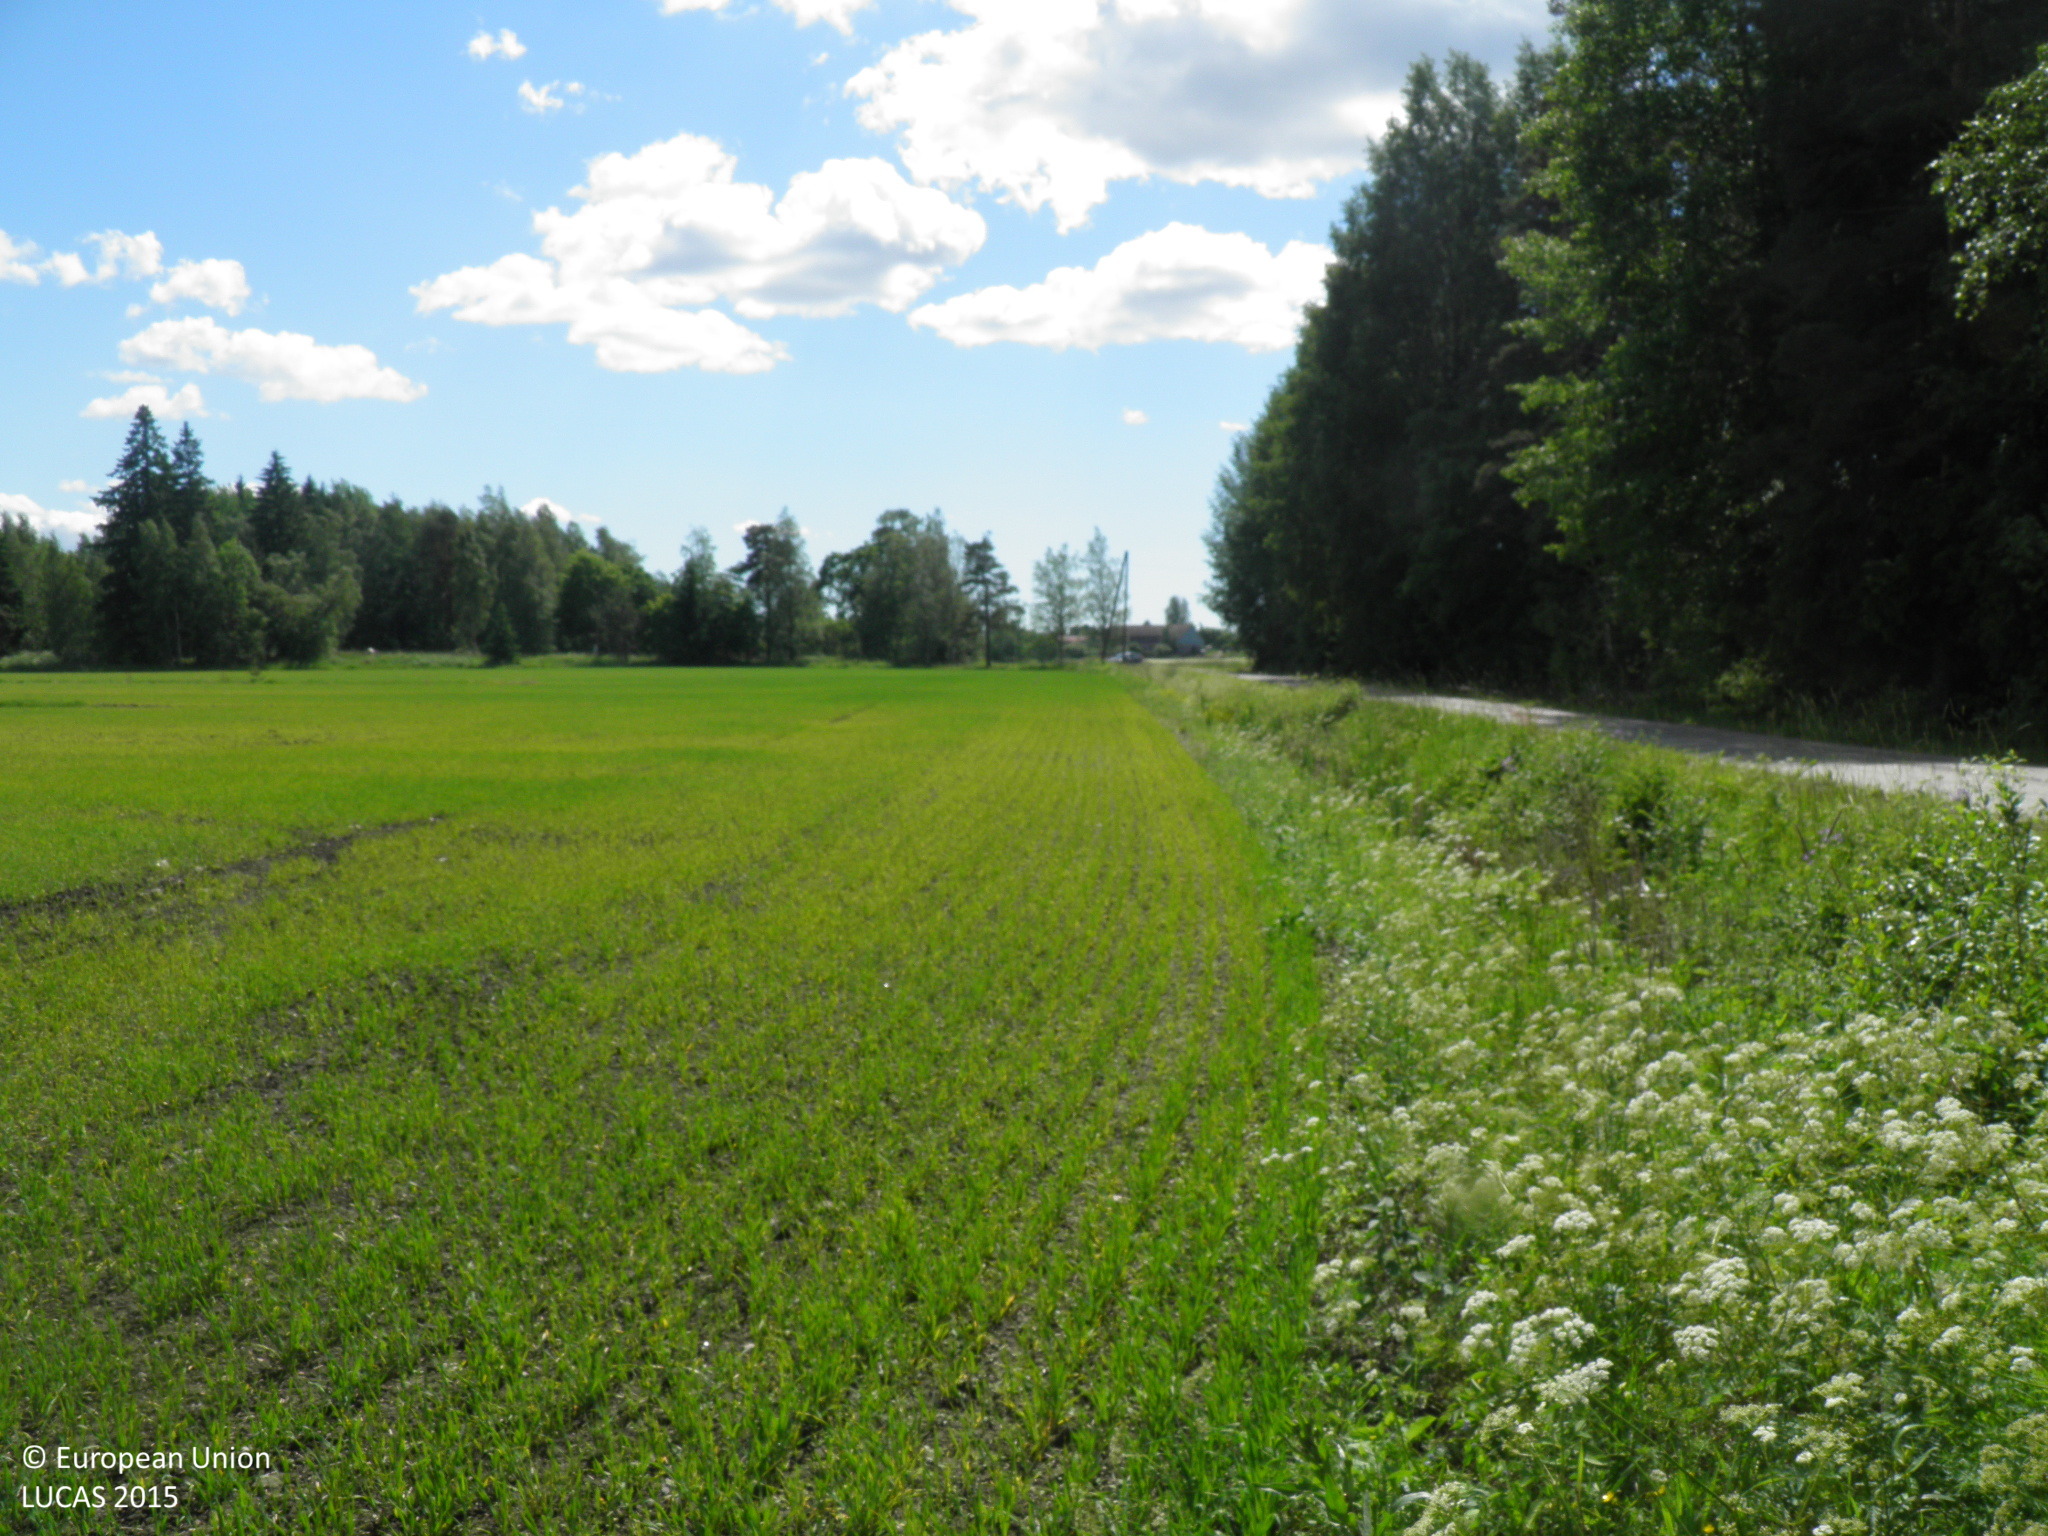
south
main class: Cropland
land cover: Barley
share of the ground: > 75 %
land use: Agriculture (excluding fallow land and kitchen gardens)
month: June
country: FI
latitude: 60.5111
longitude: 22.7679
